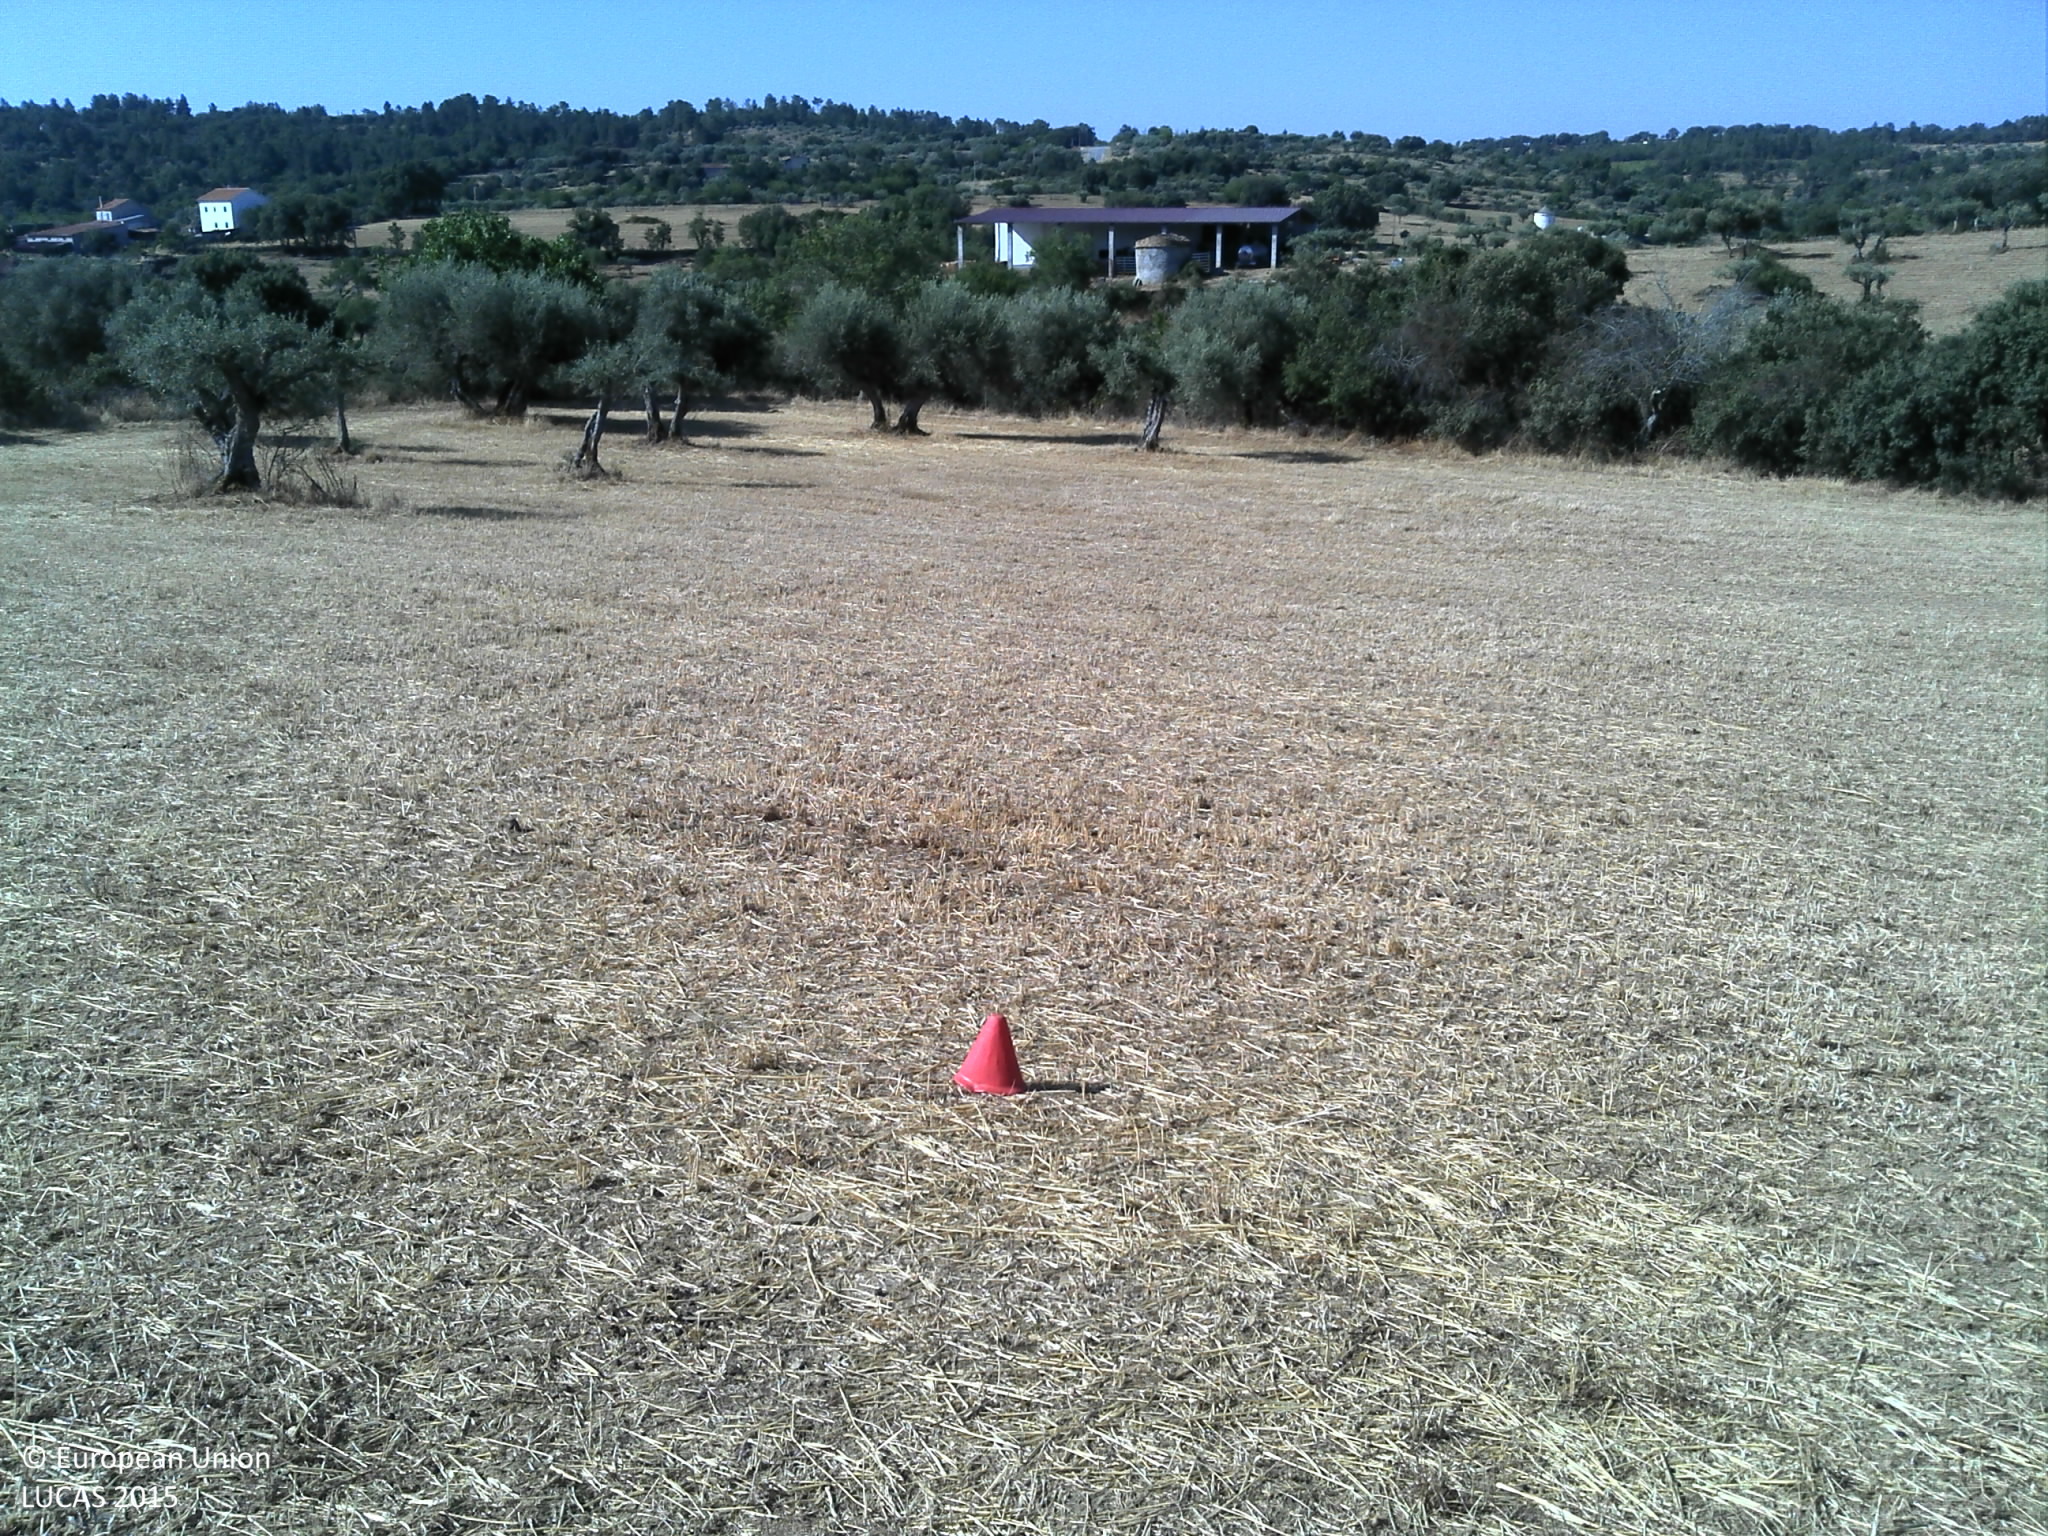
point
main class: Cropland
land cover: Oats
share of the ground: > 75 %
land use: Agriculture (excluding fallow land and kitchen gardens)
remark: Harvested field
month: June
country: PT
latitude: 40.8460
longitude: -6.8363
